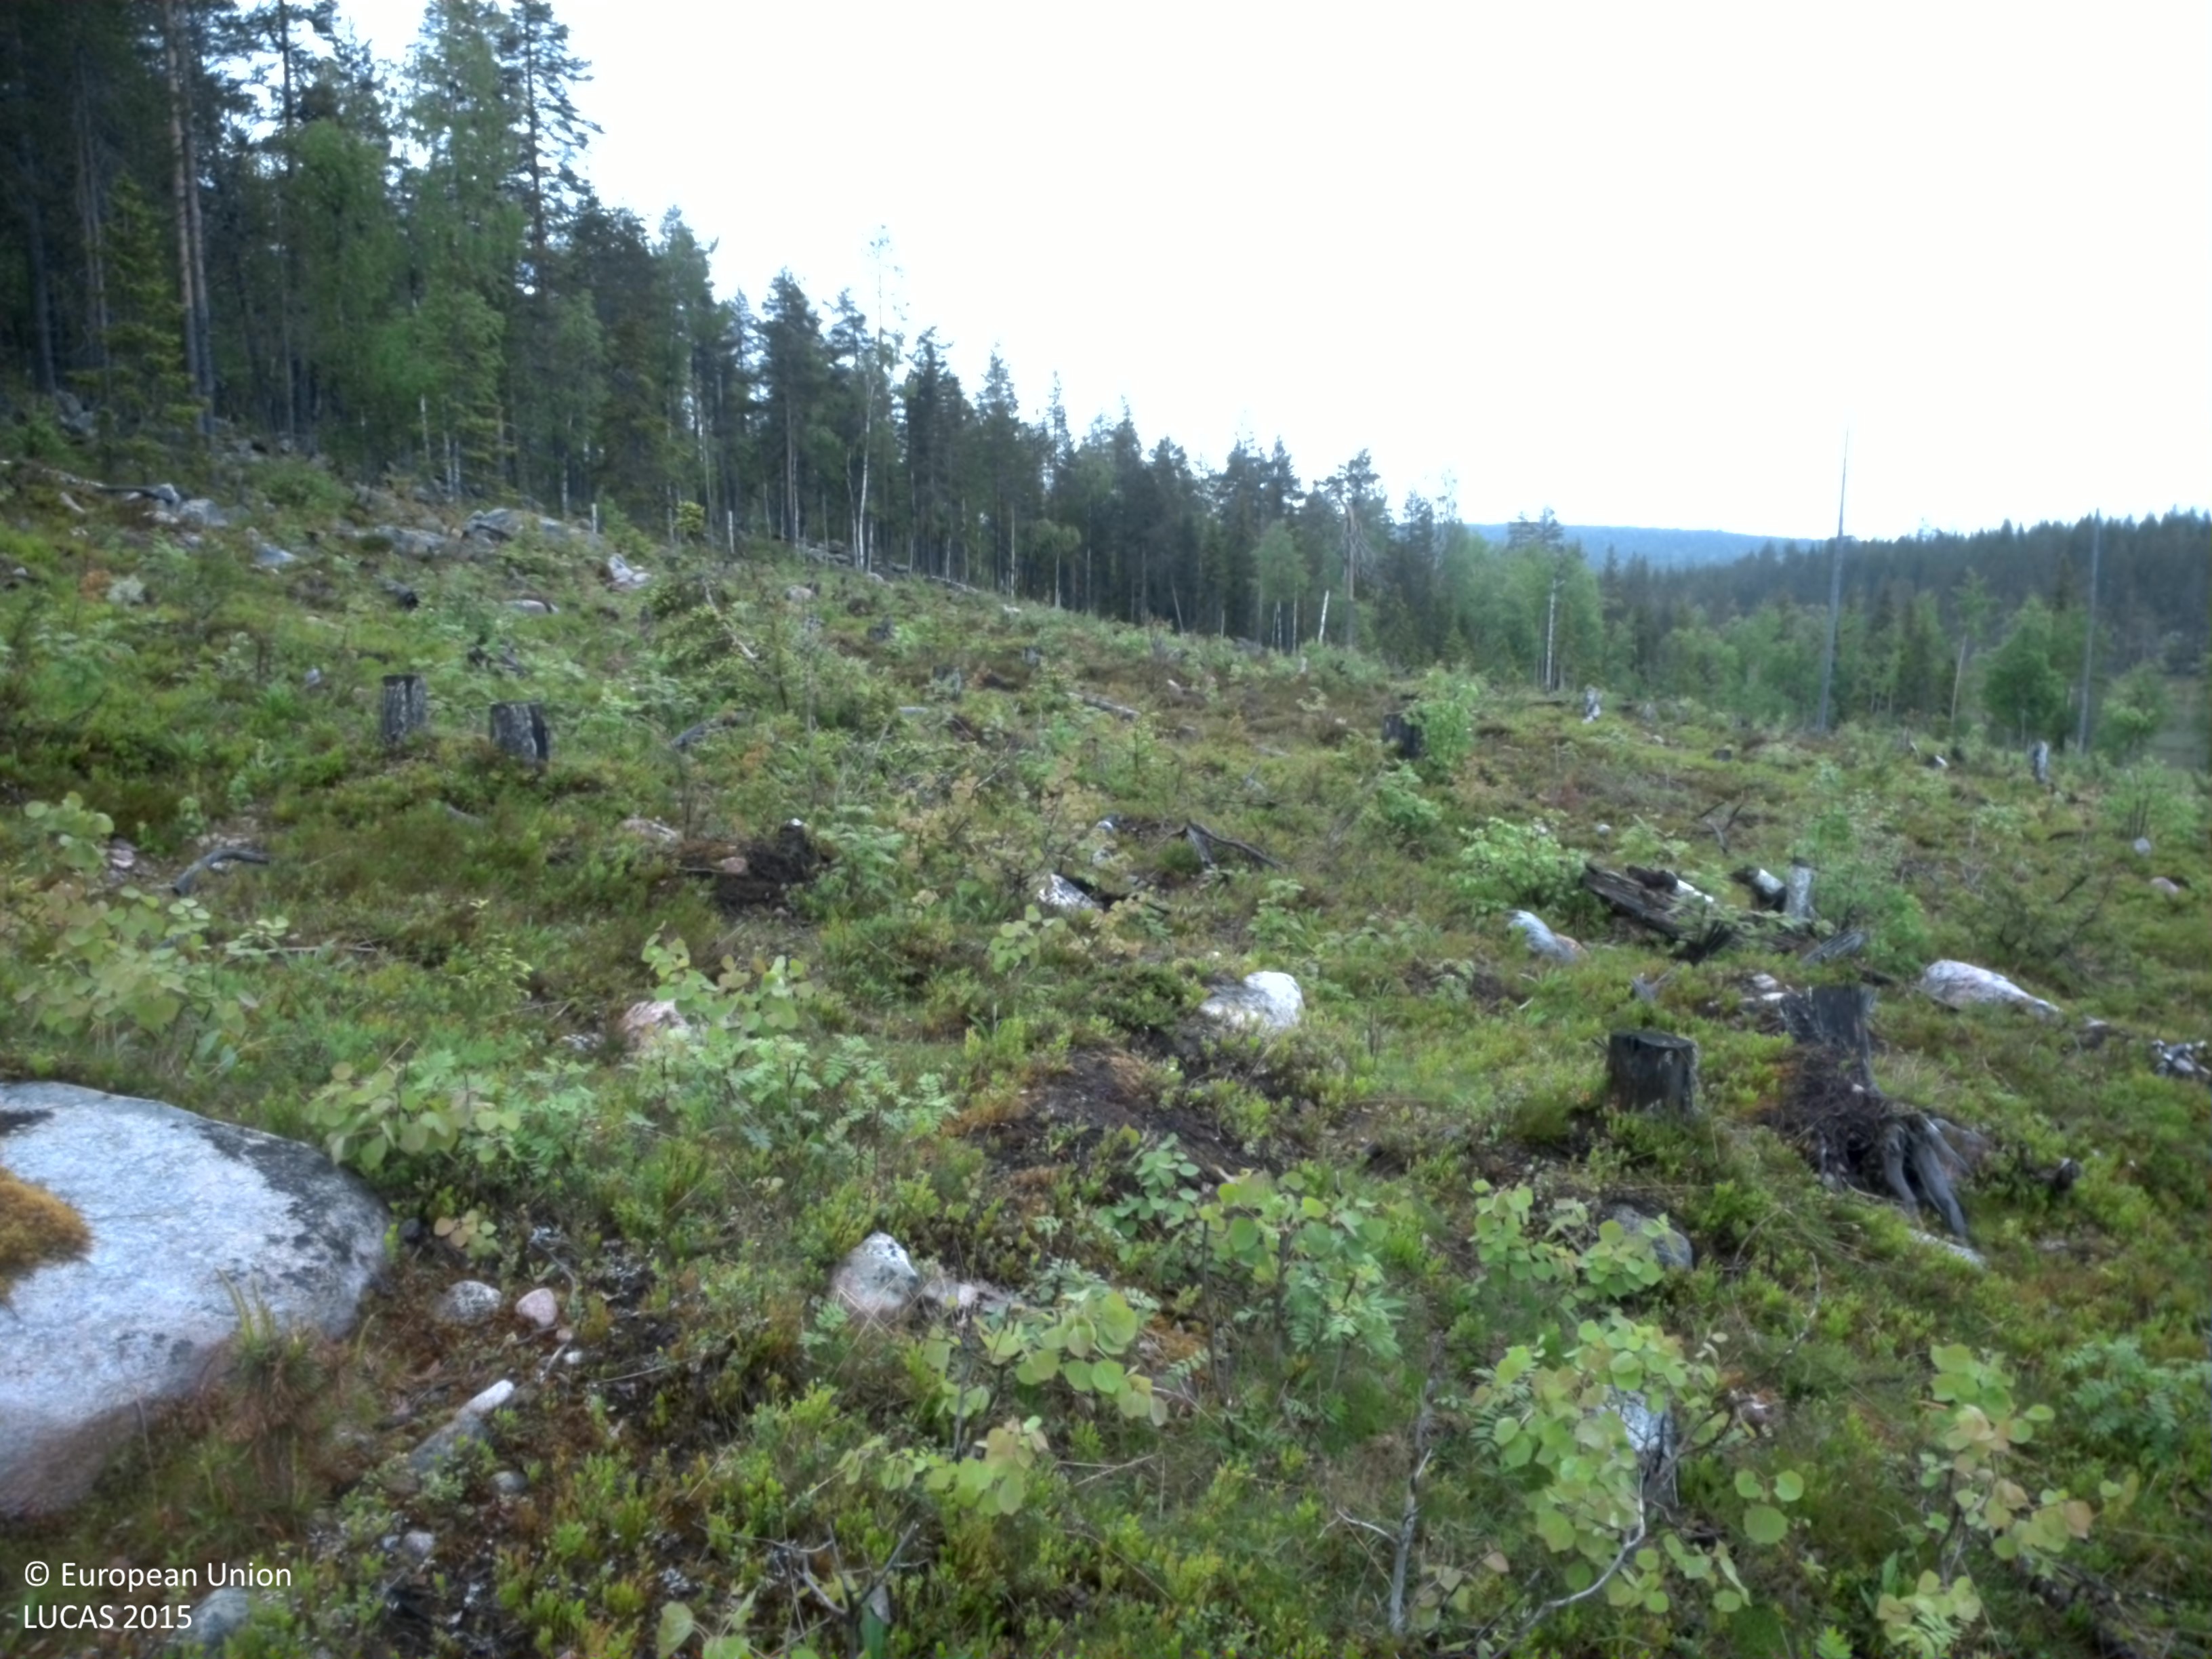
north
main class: Woodland
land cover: Broadleaved woodland
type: boreal forest
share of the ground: 10 - 25 %
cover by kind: shrubs 80 %, broadleaved forest trees 15 %, consolidated bare surface 5 %
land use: Forestry
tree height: < 5 m
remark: Clear cut
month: June
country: SE
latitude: 66.5212
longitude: 22.8185
